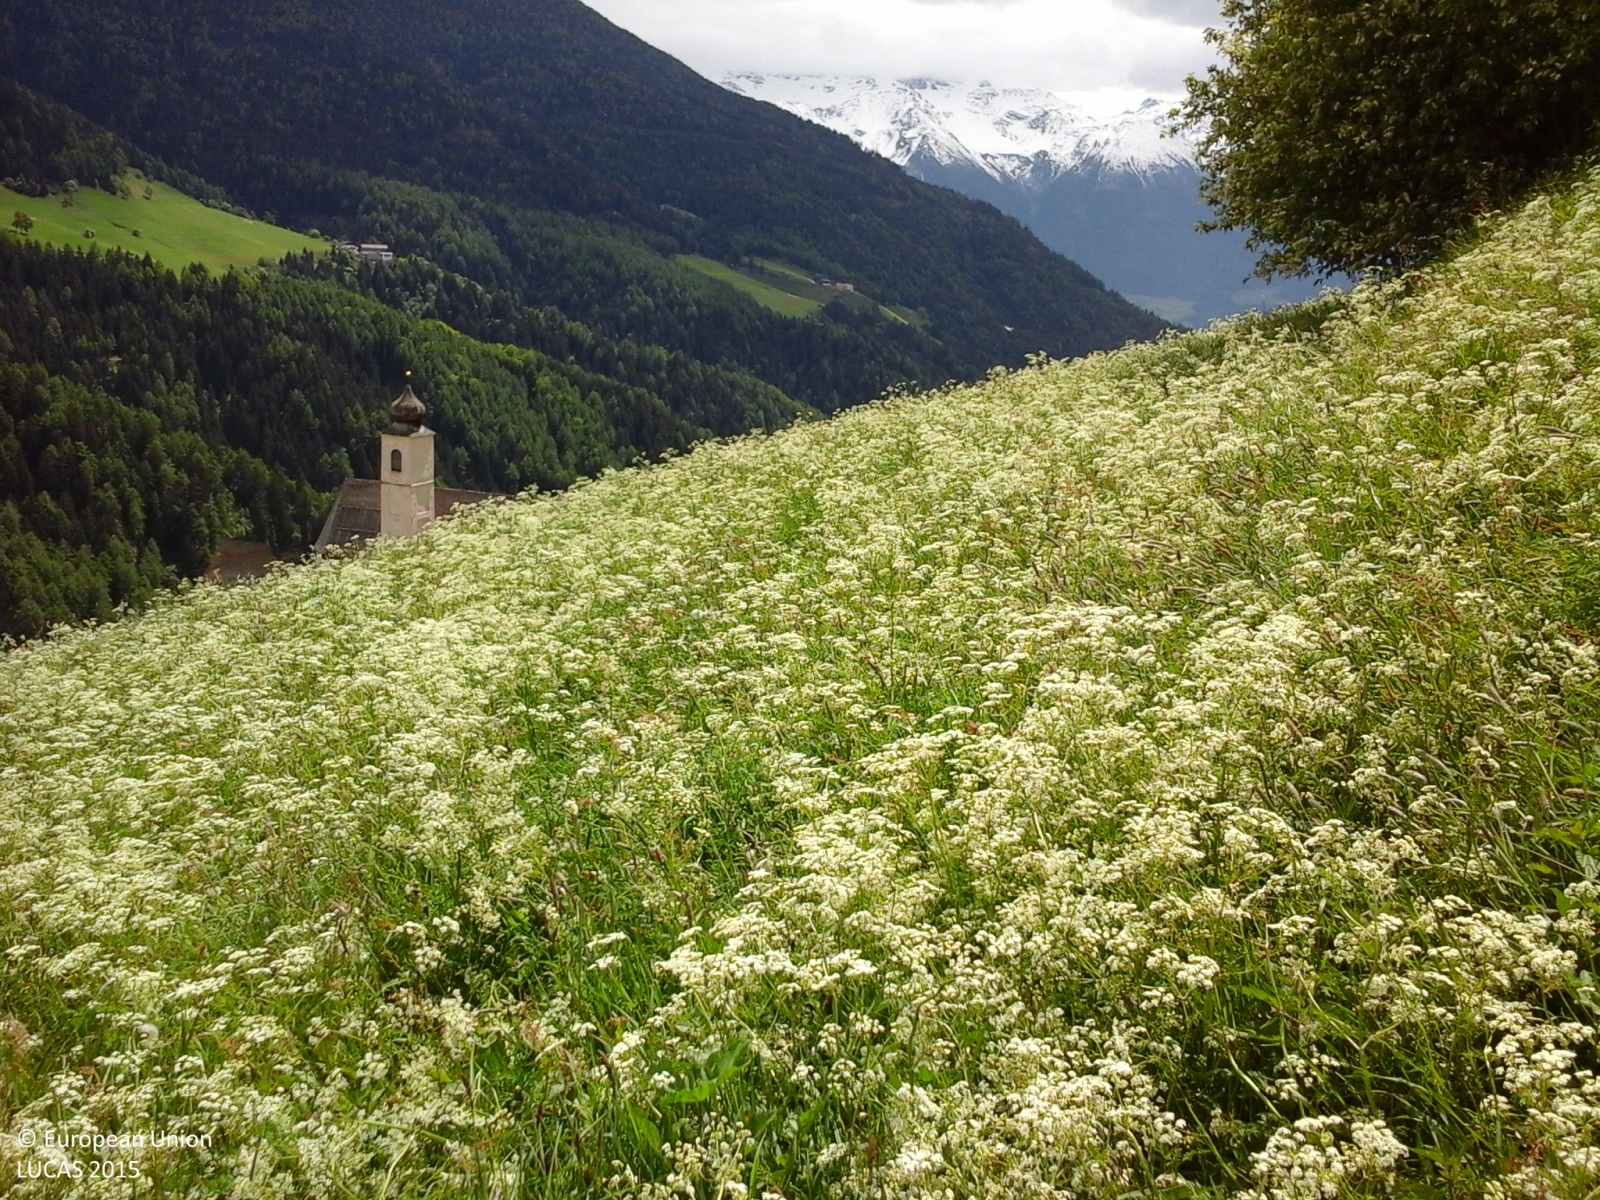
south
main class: Grassland
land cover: Grassland without tree/shrub cover
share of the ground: > 75 %
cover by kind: herbaceous plants 100 %
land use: Agriculture (excluding fallow land and kitchen gardens)
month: May
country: IT
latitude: 46.6917
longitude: 10.6138
